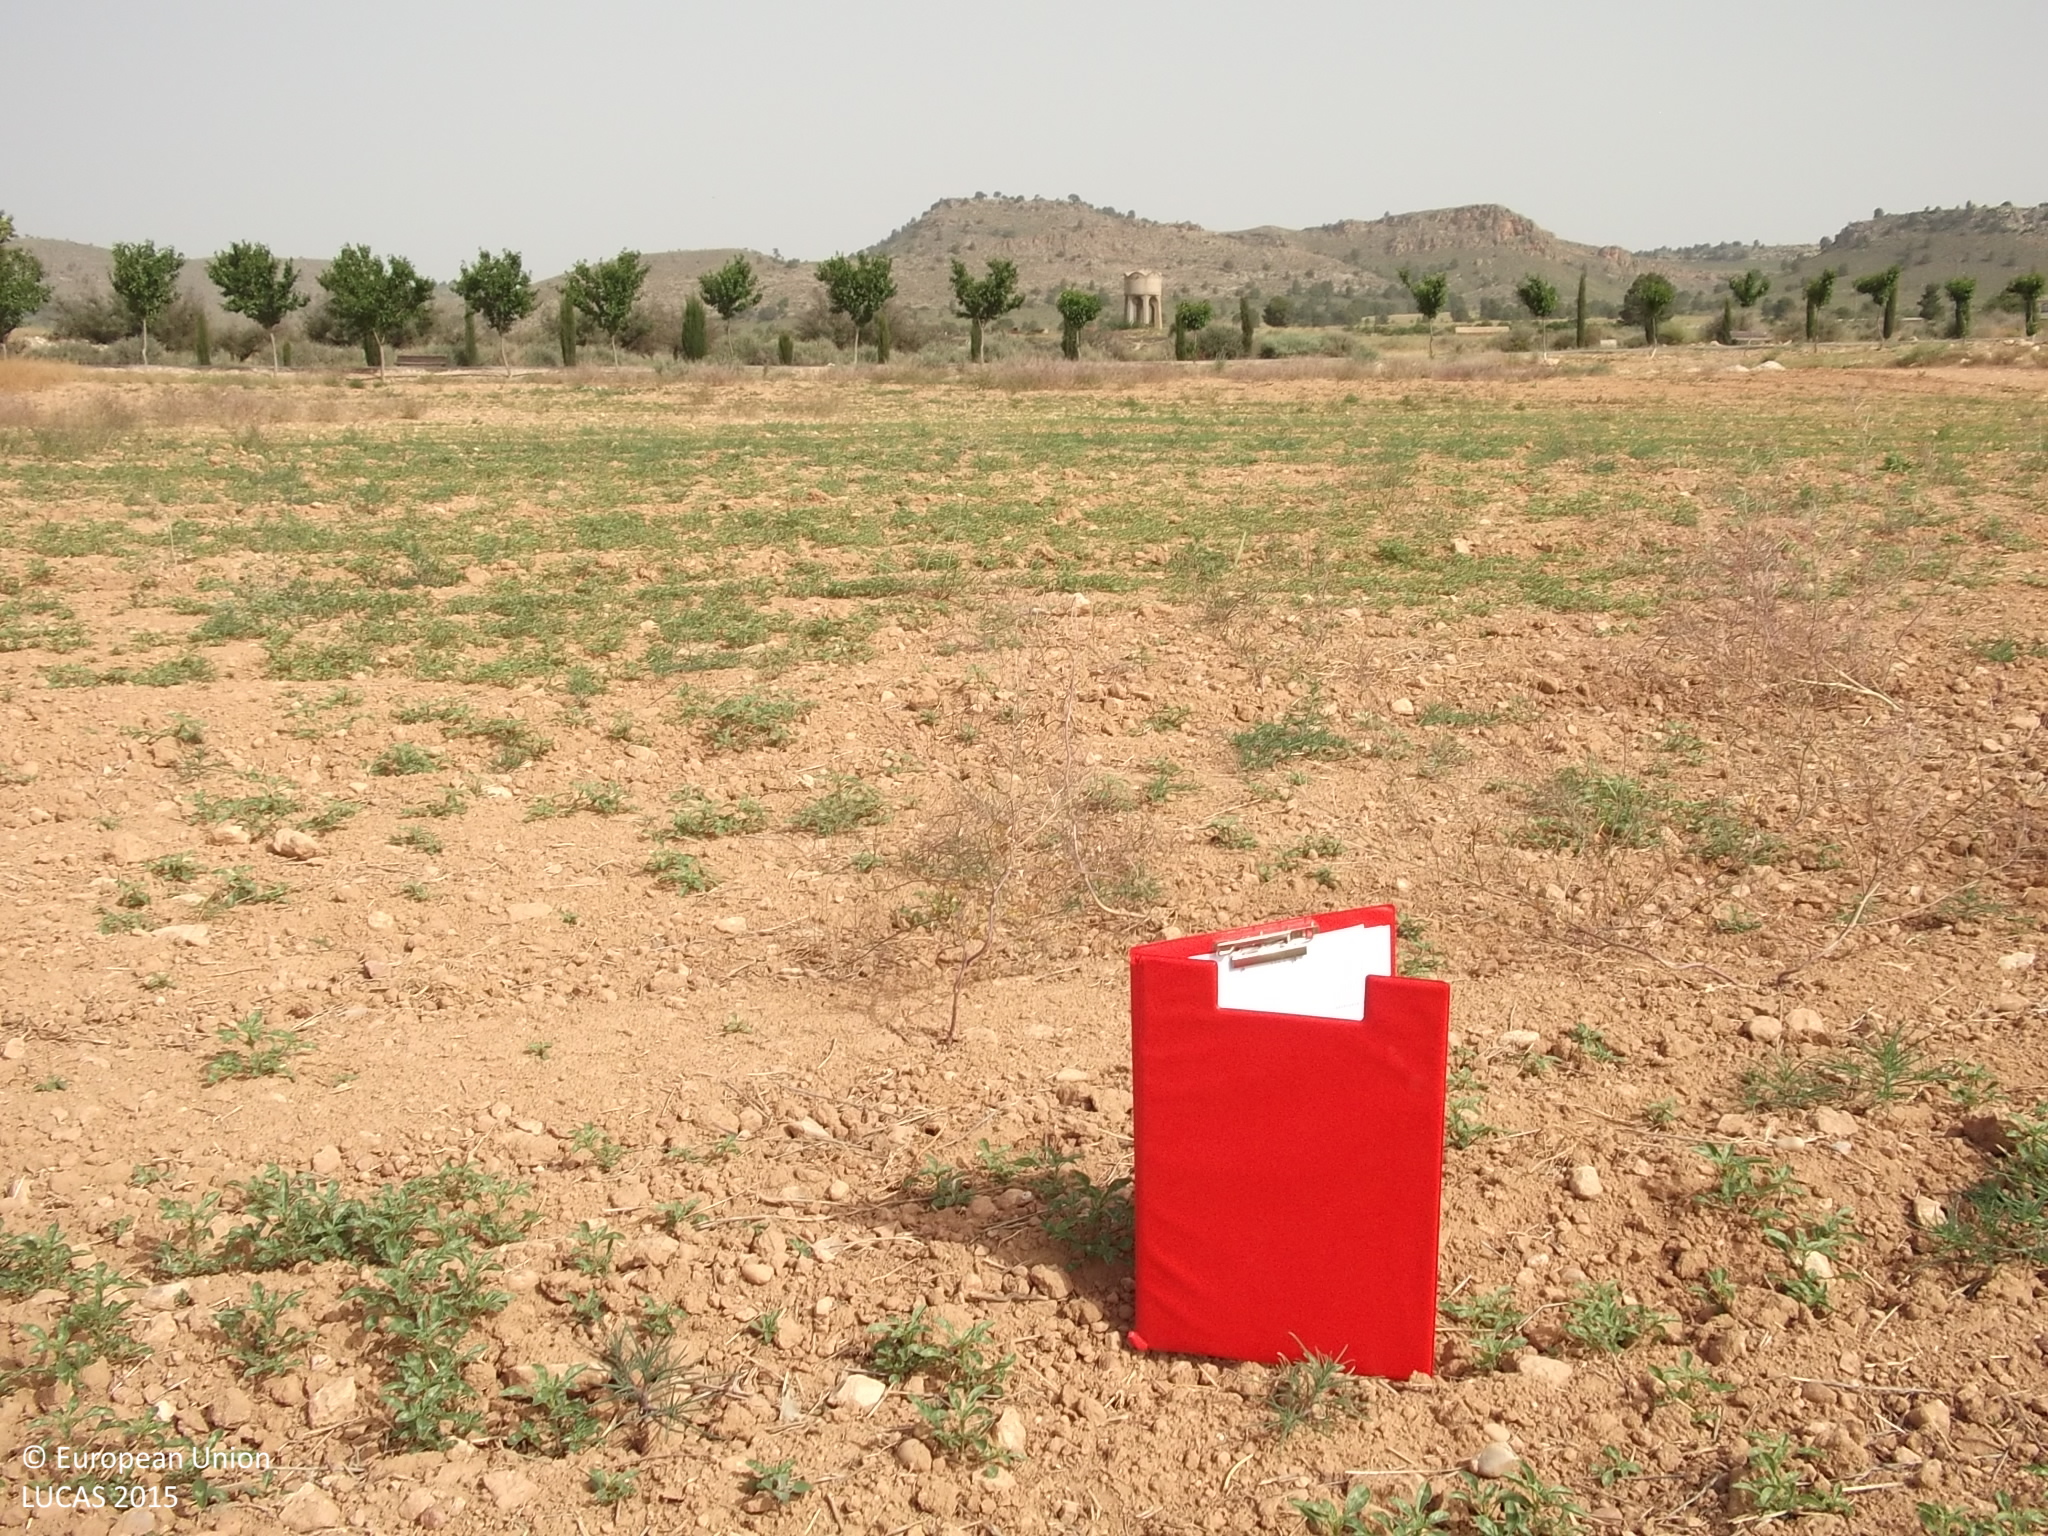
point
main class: Grassland
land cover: Spontaneously vegetated surfaces
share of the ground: 25 - 50 %
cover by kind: unconsolidated bare surface 70 %, herbaceous plants 30 %
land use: Fallow land
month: May
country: ES
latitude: 38.4206
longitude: -1.6404
